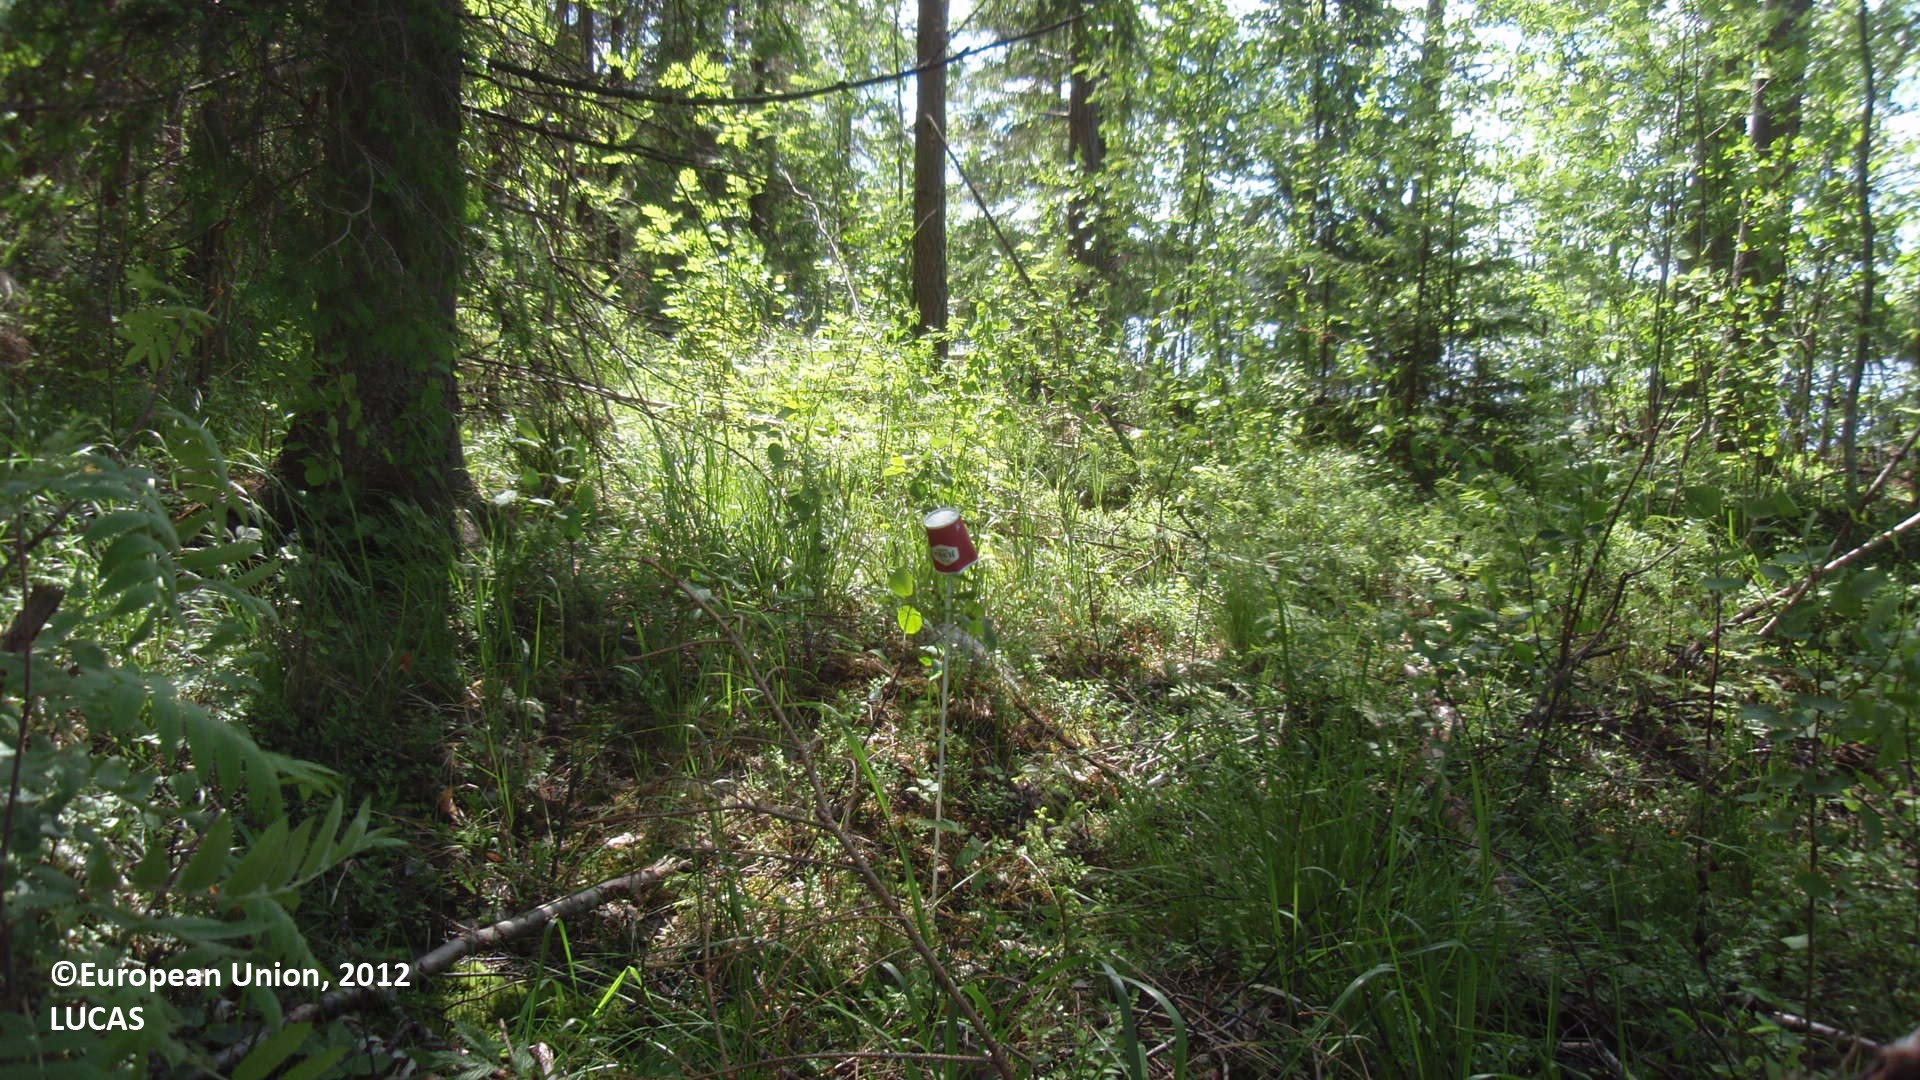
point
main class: Woodland
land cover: Spruce dominated mixed woodland
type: boreal forest
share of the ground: 50 - 75 %
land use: Forestry
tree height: > 5 m
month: June
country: FI
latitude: 61.5974
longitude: 26.6792
